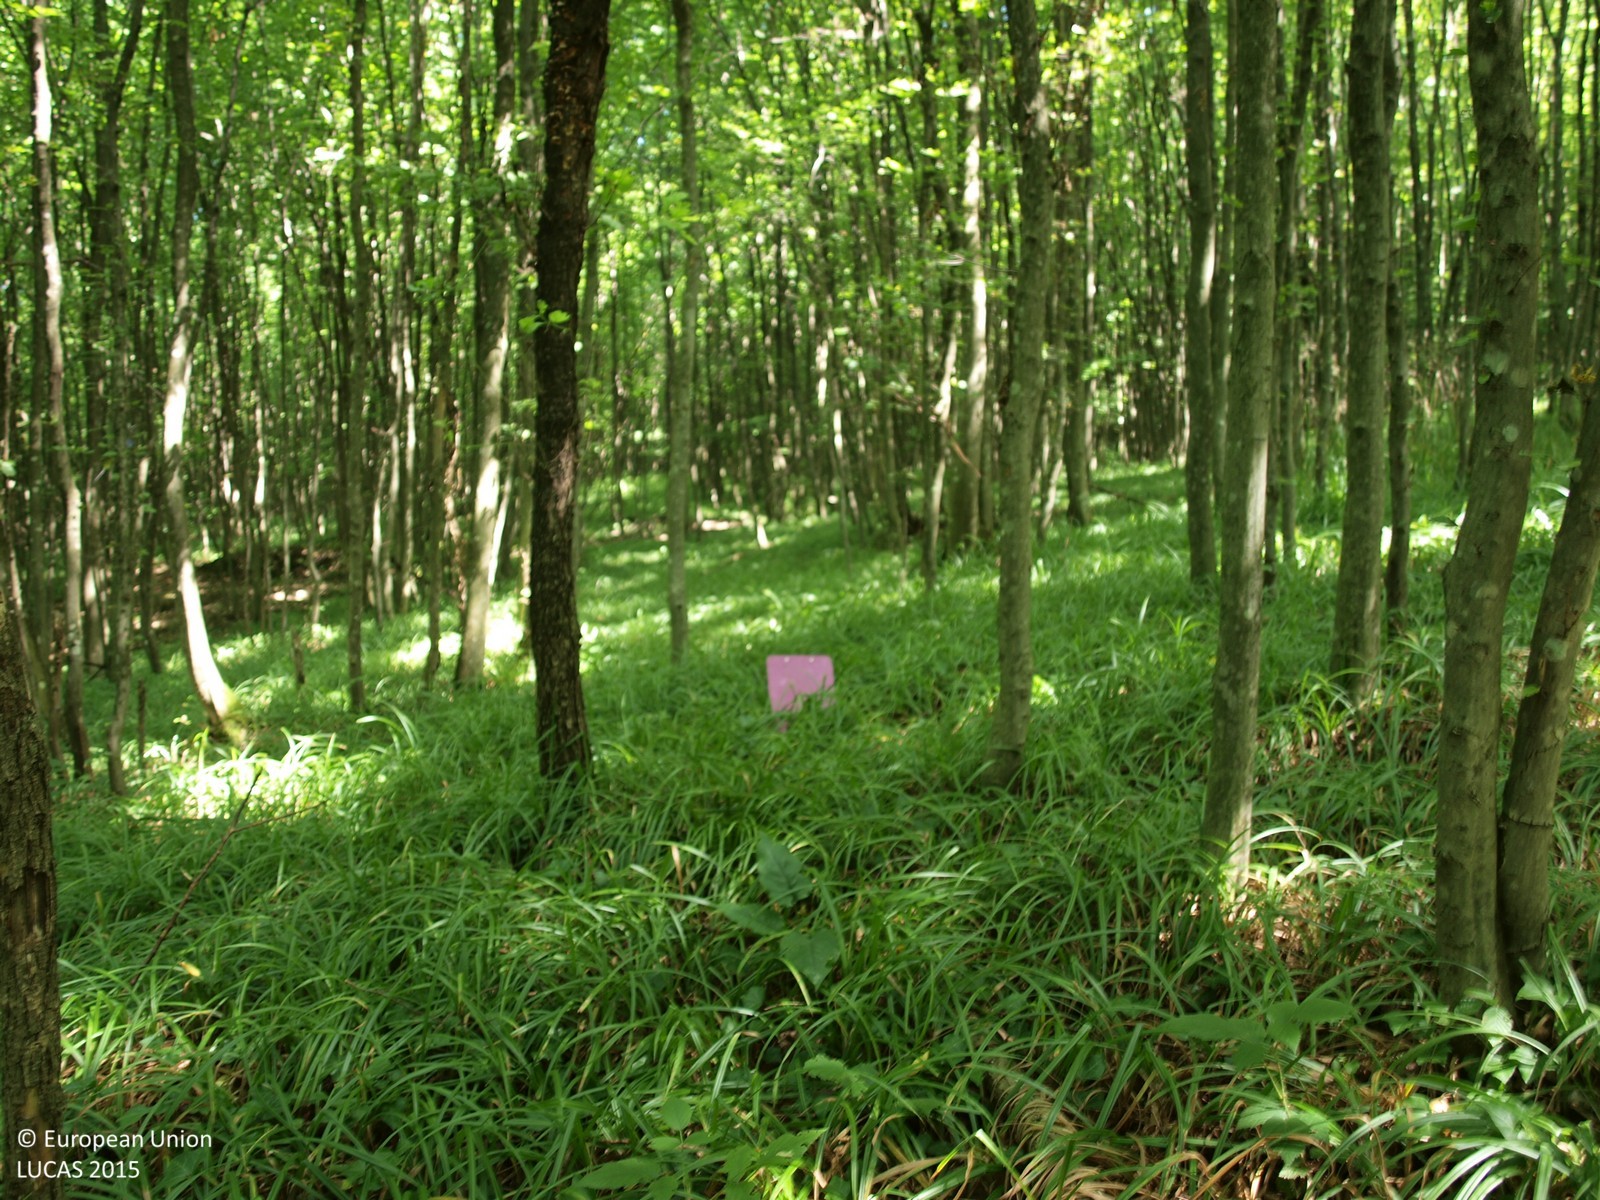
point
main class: Woodland
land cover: Broadleaved woodland
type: mesophytic deciduous forest
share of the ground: > 75 %
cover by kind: broadleaved forest trees 100 %
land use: Forestry
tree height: > 5 m
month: August
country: HR
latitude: 46.0154
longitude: 16.3929
